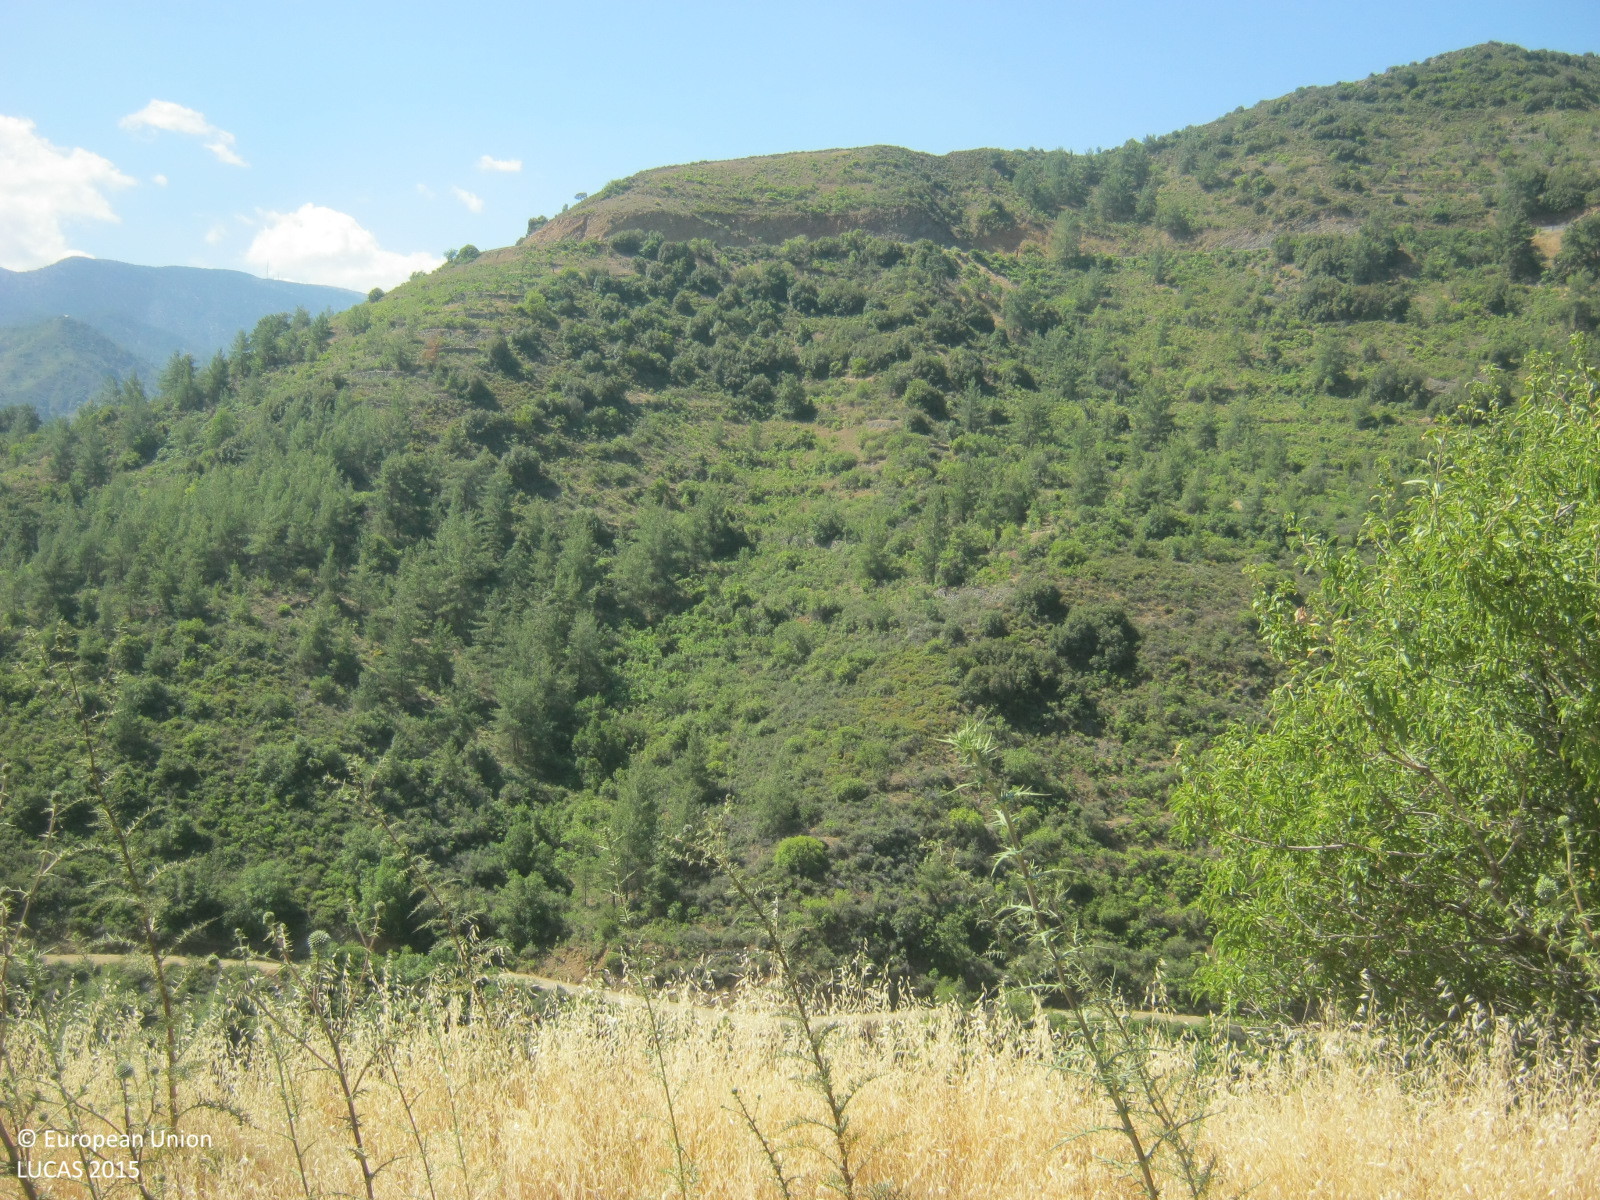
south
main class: Shrubland
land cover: Shrubland without tree cover
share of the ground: 25 - 50 %
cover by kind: herbaceous plants 60 %, shrubs 30 %, unconsolidated bare surface 10 %
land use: Semi-natural and natural areas not in use
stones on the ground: 25 - 50 %
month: June
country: CY
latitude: 35.0092
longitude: 32.8173
